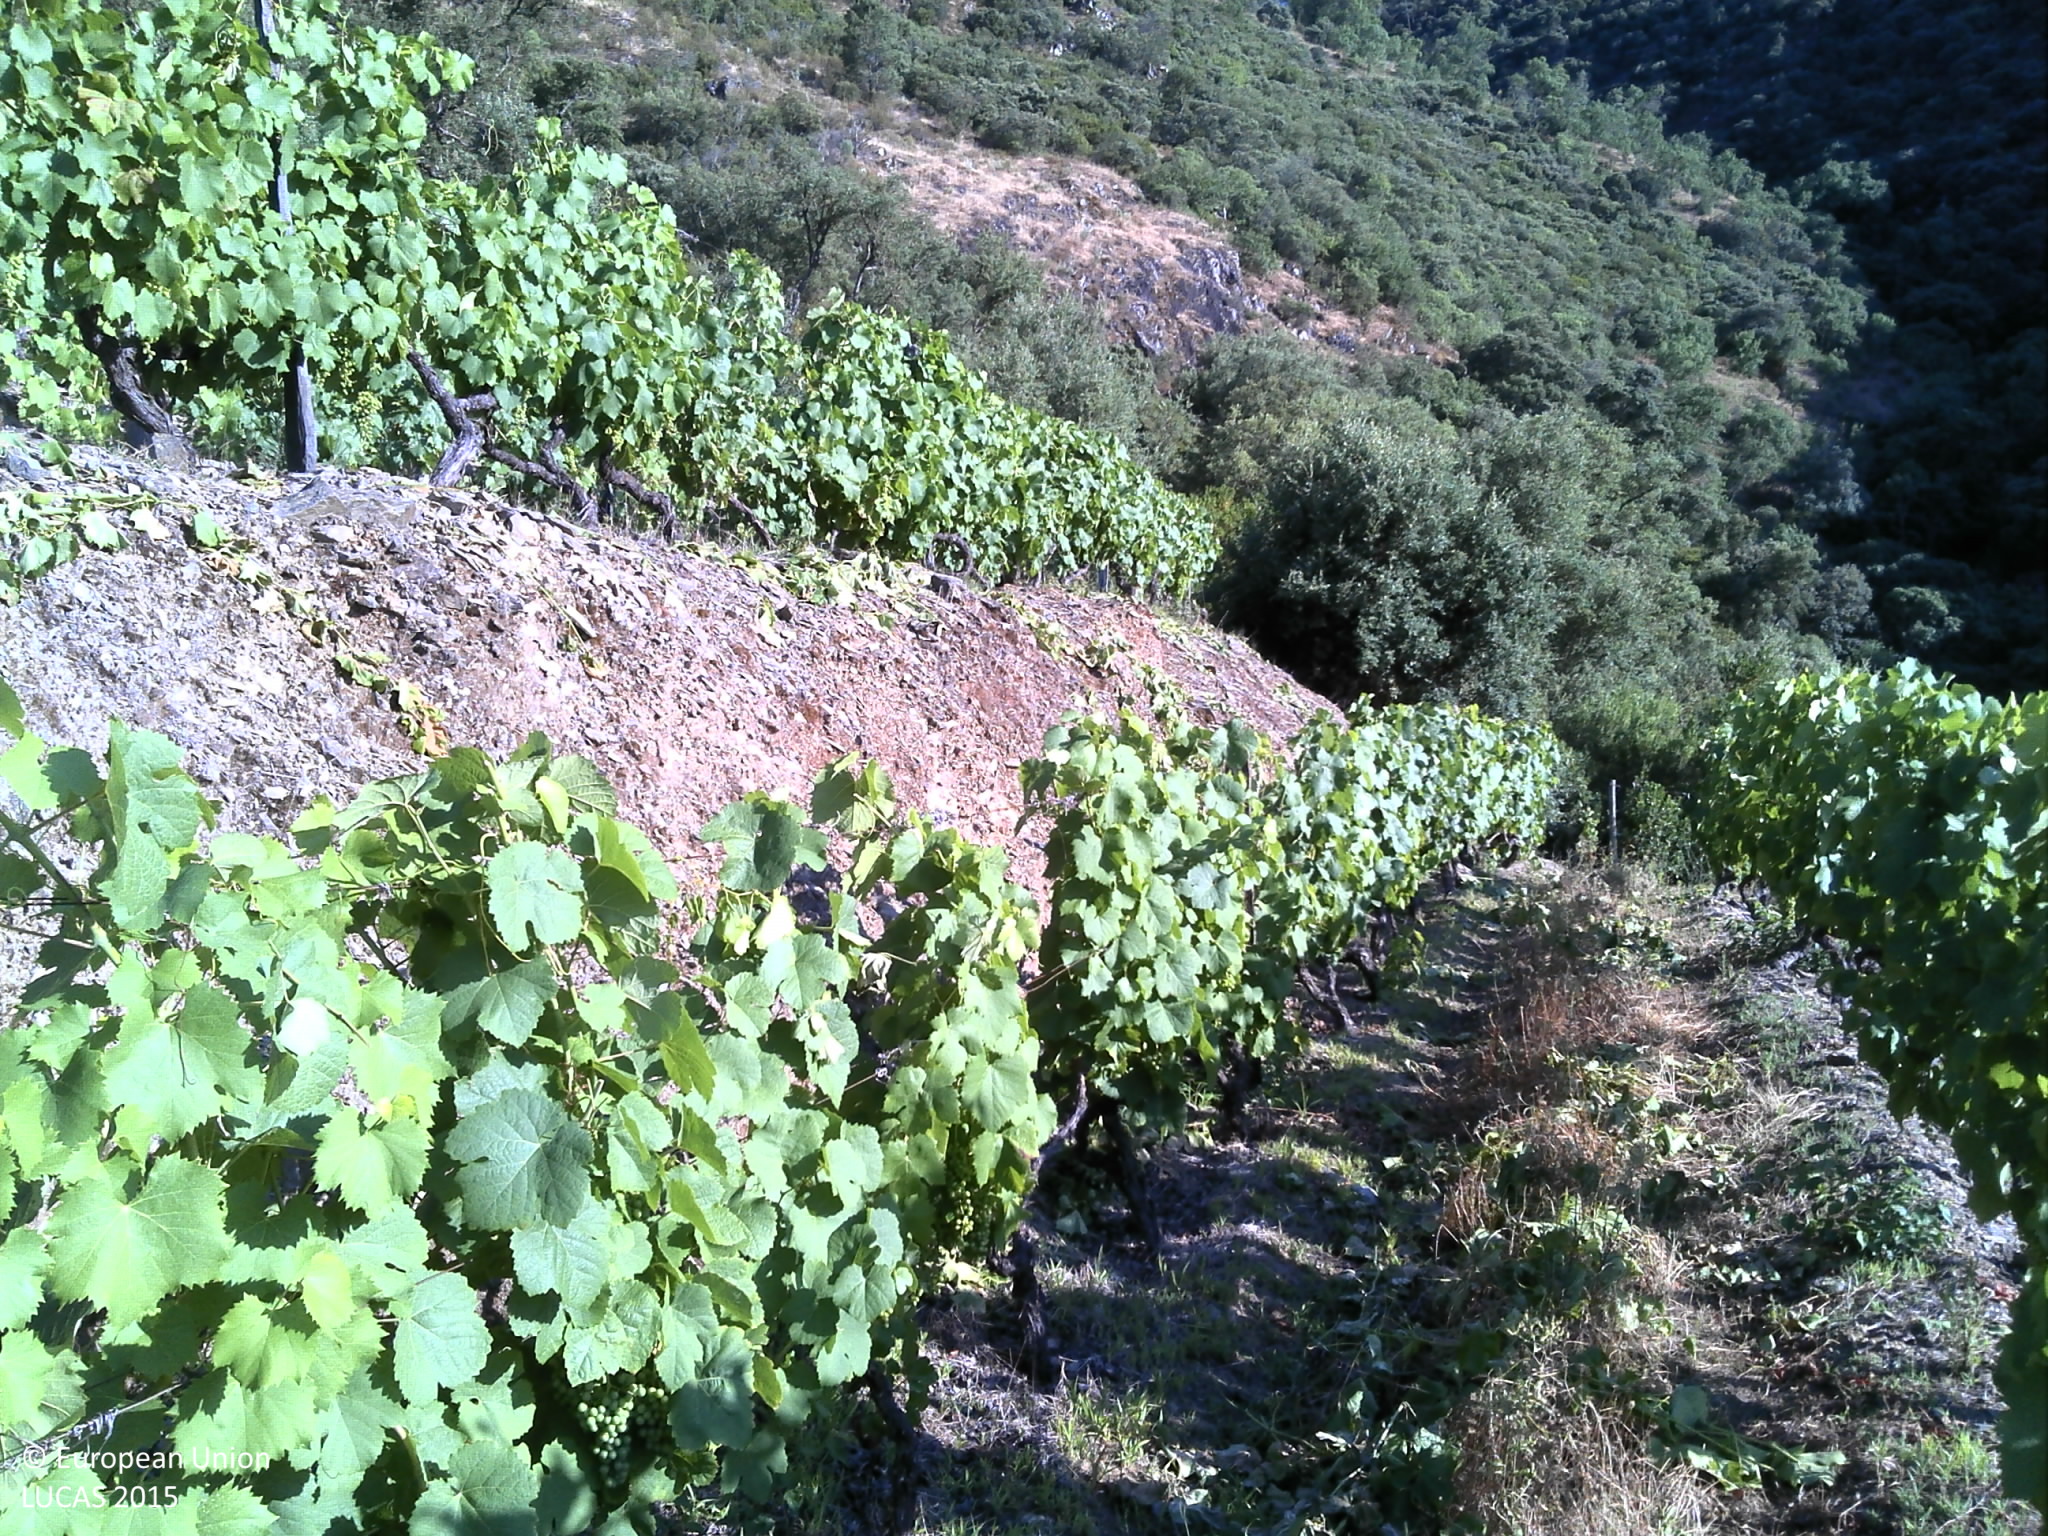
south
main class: Cropland
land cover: Vineyards
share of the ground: 10 - 25 %
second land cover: Grassland without tree/shrub cover
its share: 25 - 50 %
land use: Agriculture (excluding fallow land and kitchen gardens)
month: June
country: PT
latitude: 41.1529
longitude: -7.6053
